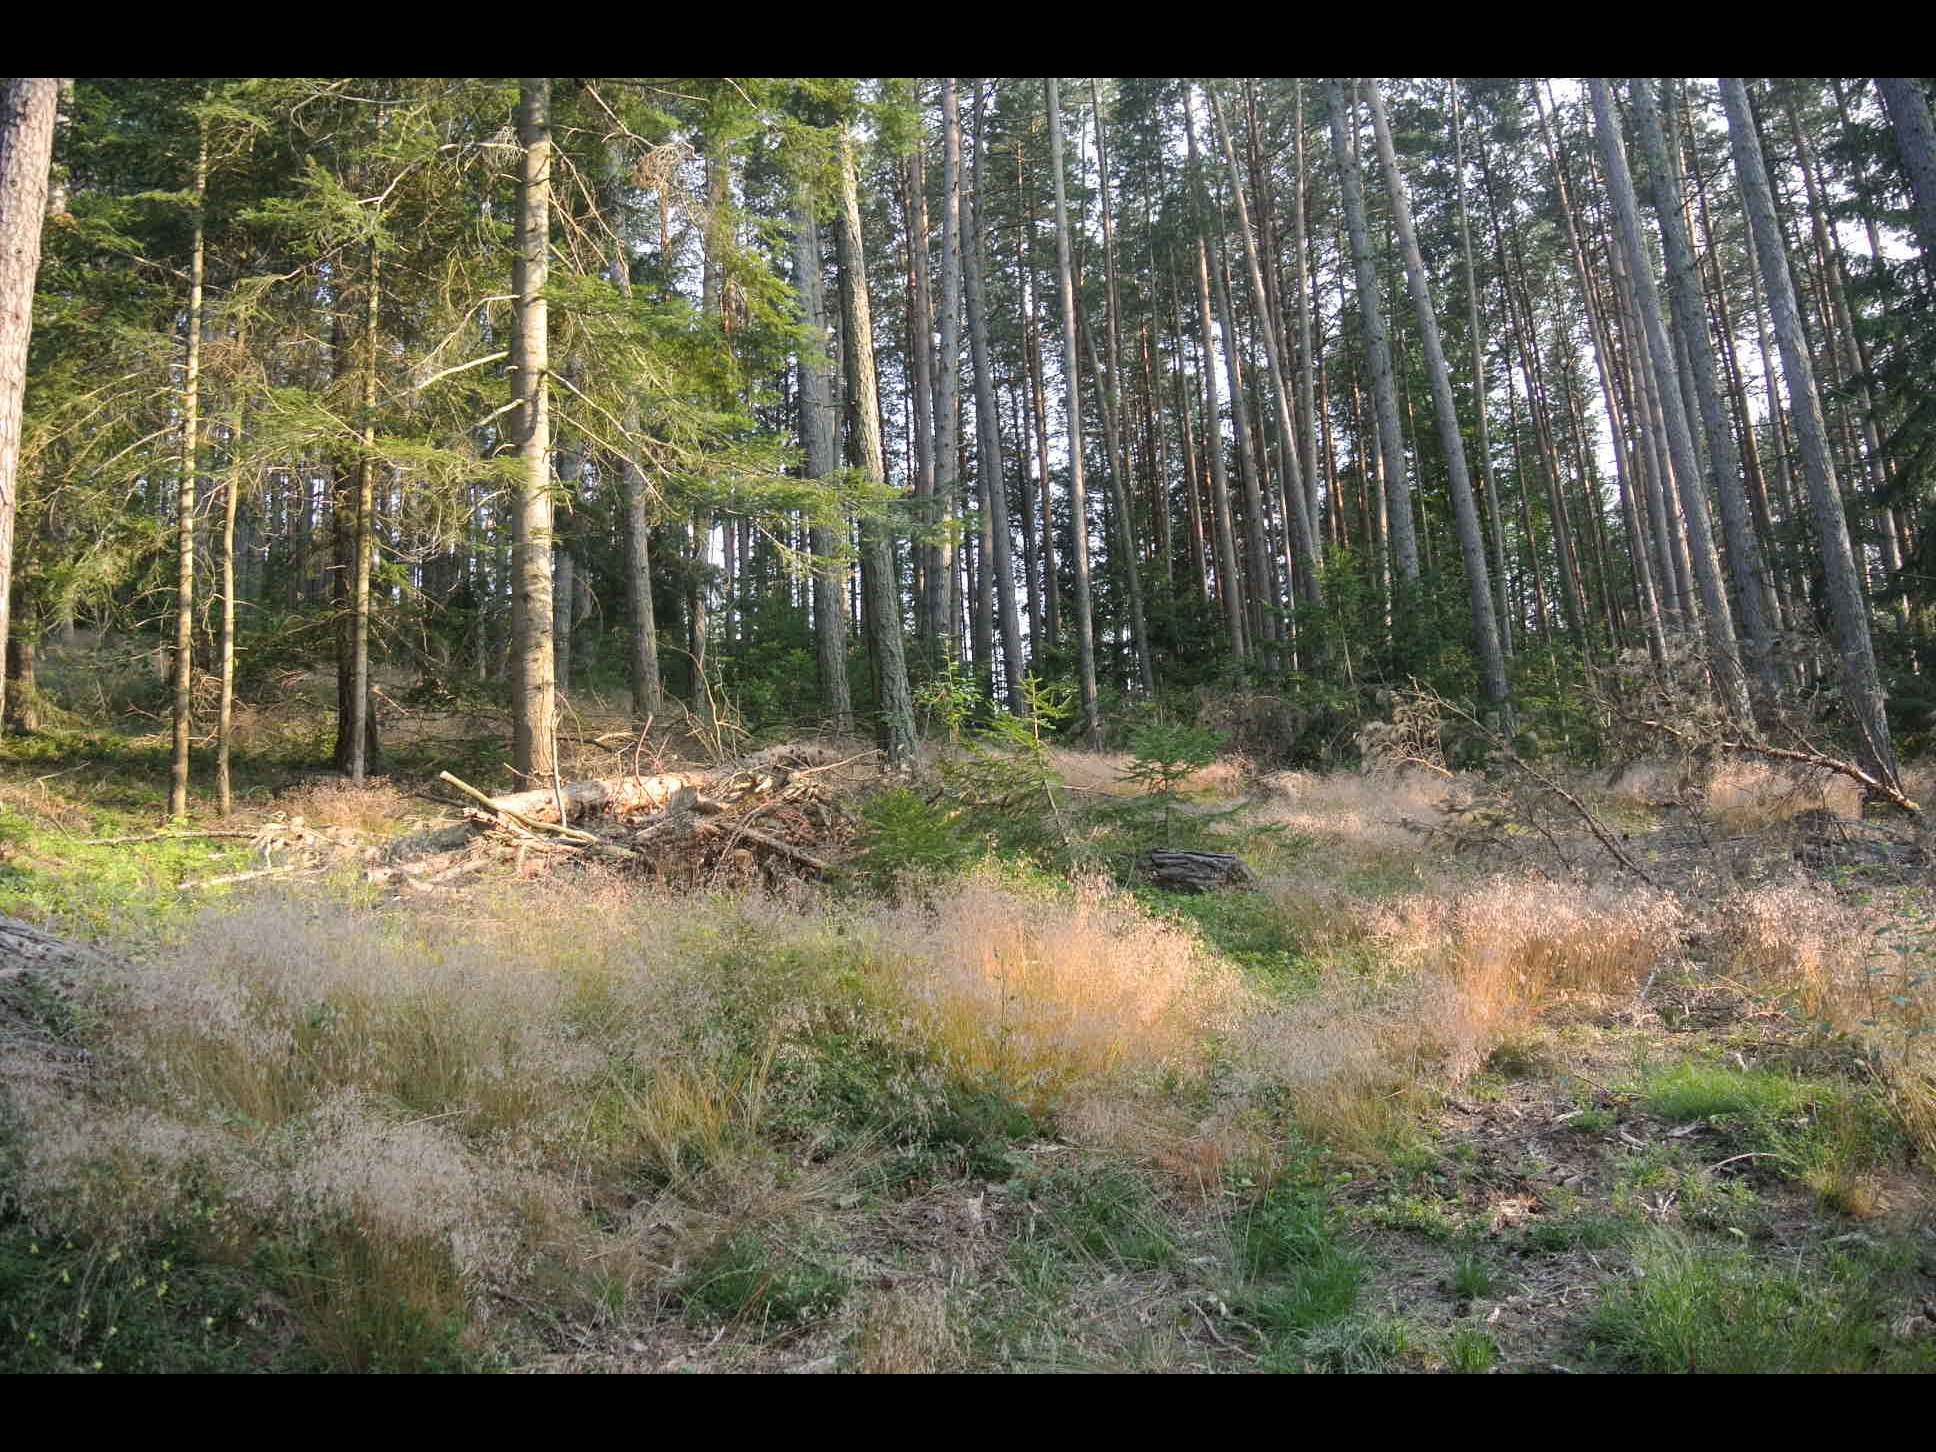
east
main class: Woodland
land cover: Other coniferous woodland
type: alpine coniferous forest
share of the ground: > 75 %
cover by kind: coniferous forest trees 100 %
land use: Forestry
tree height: > 5 m
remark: Clear cut
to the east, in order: Other coniferous woodland; Grassland without tree/shrub cover; Spruce dominated coniferous woodland; Pine dominated mixed woodland; Tracks; Grassland without tree/shrub cover; Tracks; Fences; Artificial constructions in urban areas
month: July
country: AT
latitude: 47.5119
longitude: 16.1238
